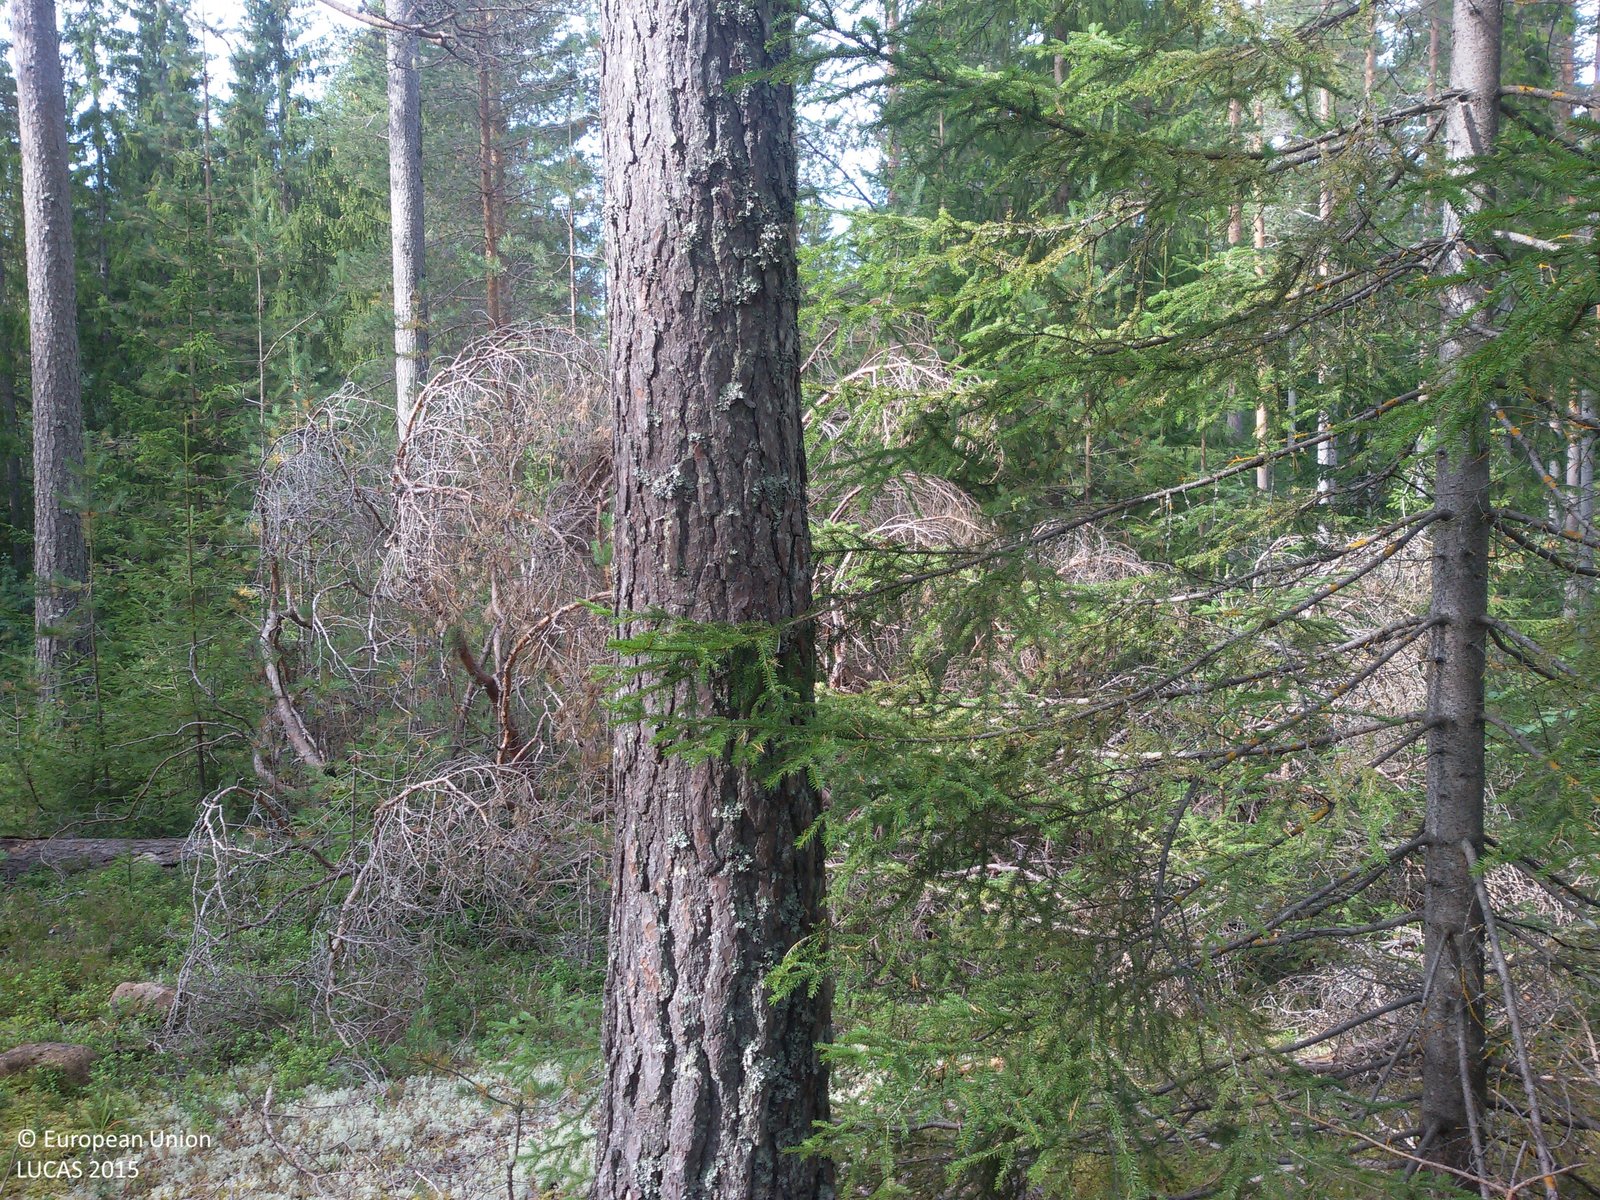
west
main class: Woodland
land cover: Pine dominated coniferous woodland
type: boreal forest
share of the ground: 50 - 75 %
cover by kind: coniferous forest trees 60 %, lichens and mosses 30 %, herbaceous plants 10 %
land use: Forestry
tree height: > 5 m
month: September
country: SE
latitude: 60.9853
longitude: 15.2535
